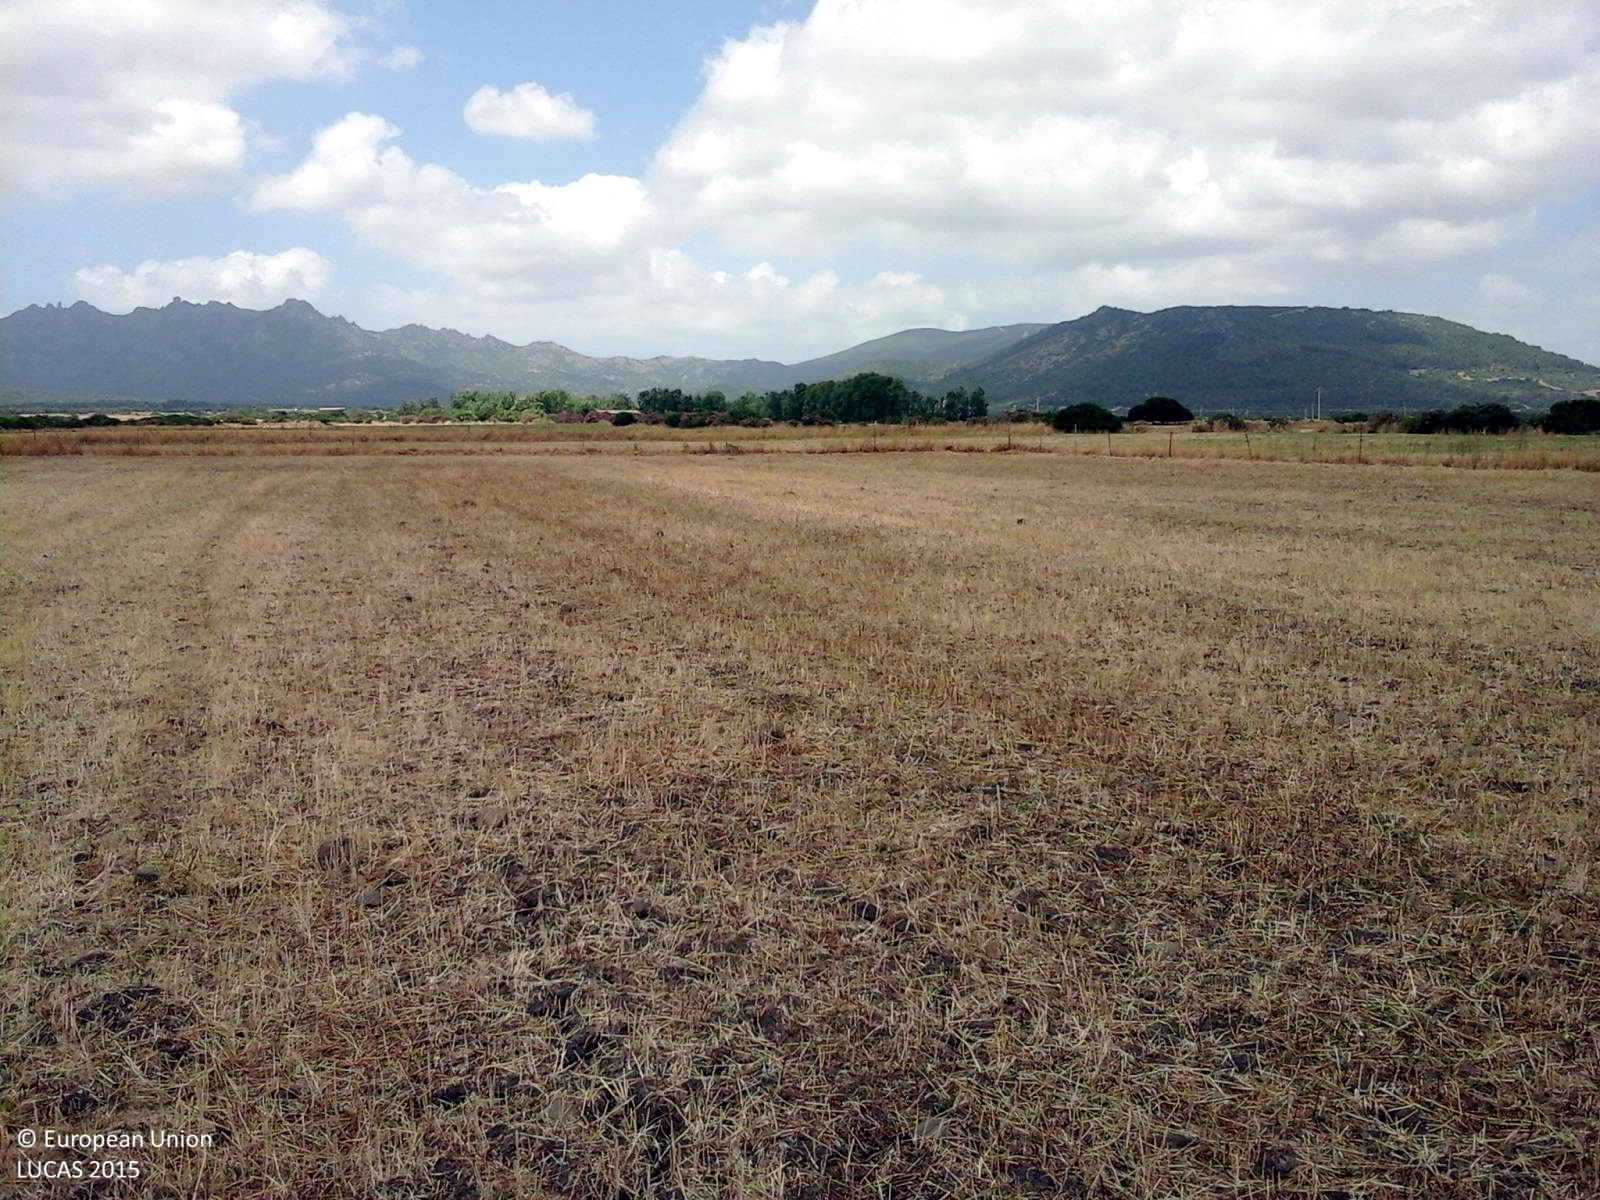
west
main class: Cropland
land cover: Temporary grasslands
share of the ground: > 75 %
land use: Agriculture (excluding fallow land and kitchen gardens)
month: June
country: IT
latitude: 39.6234
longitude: 8.5985
